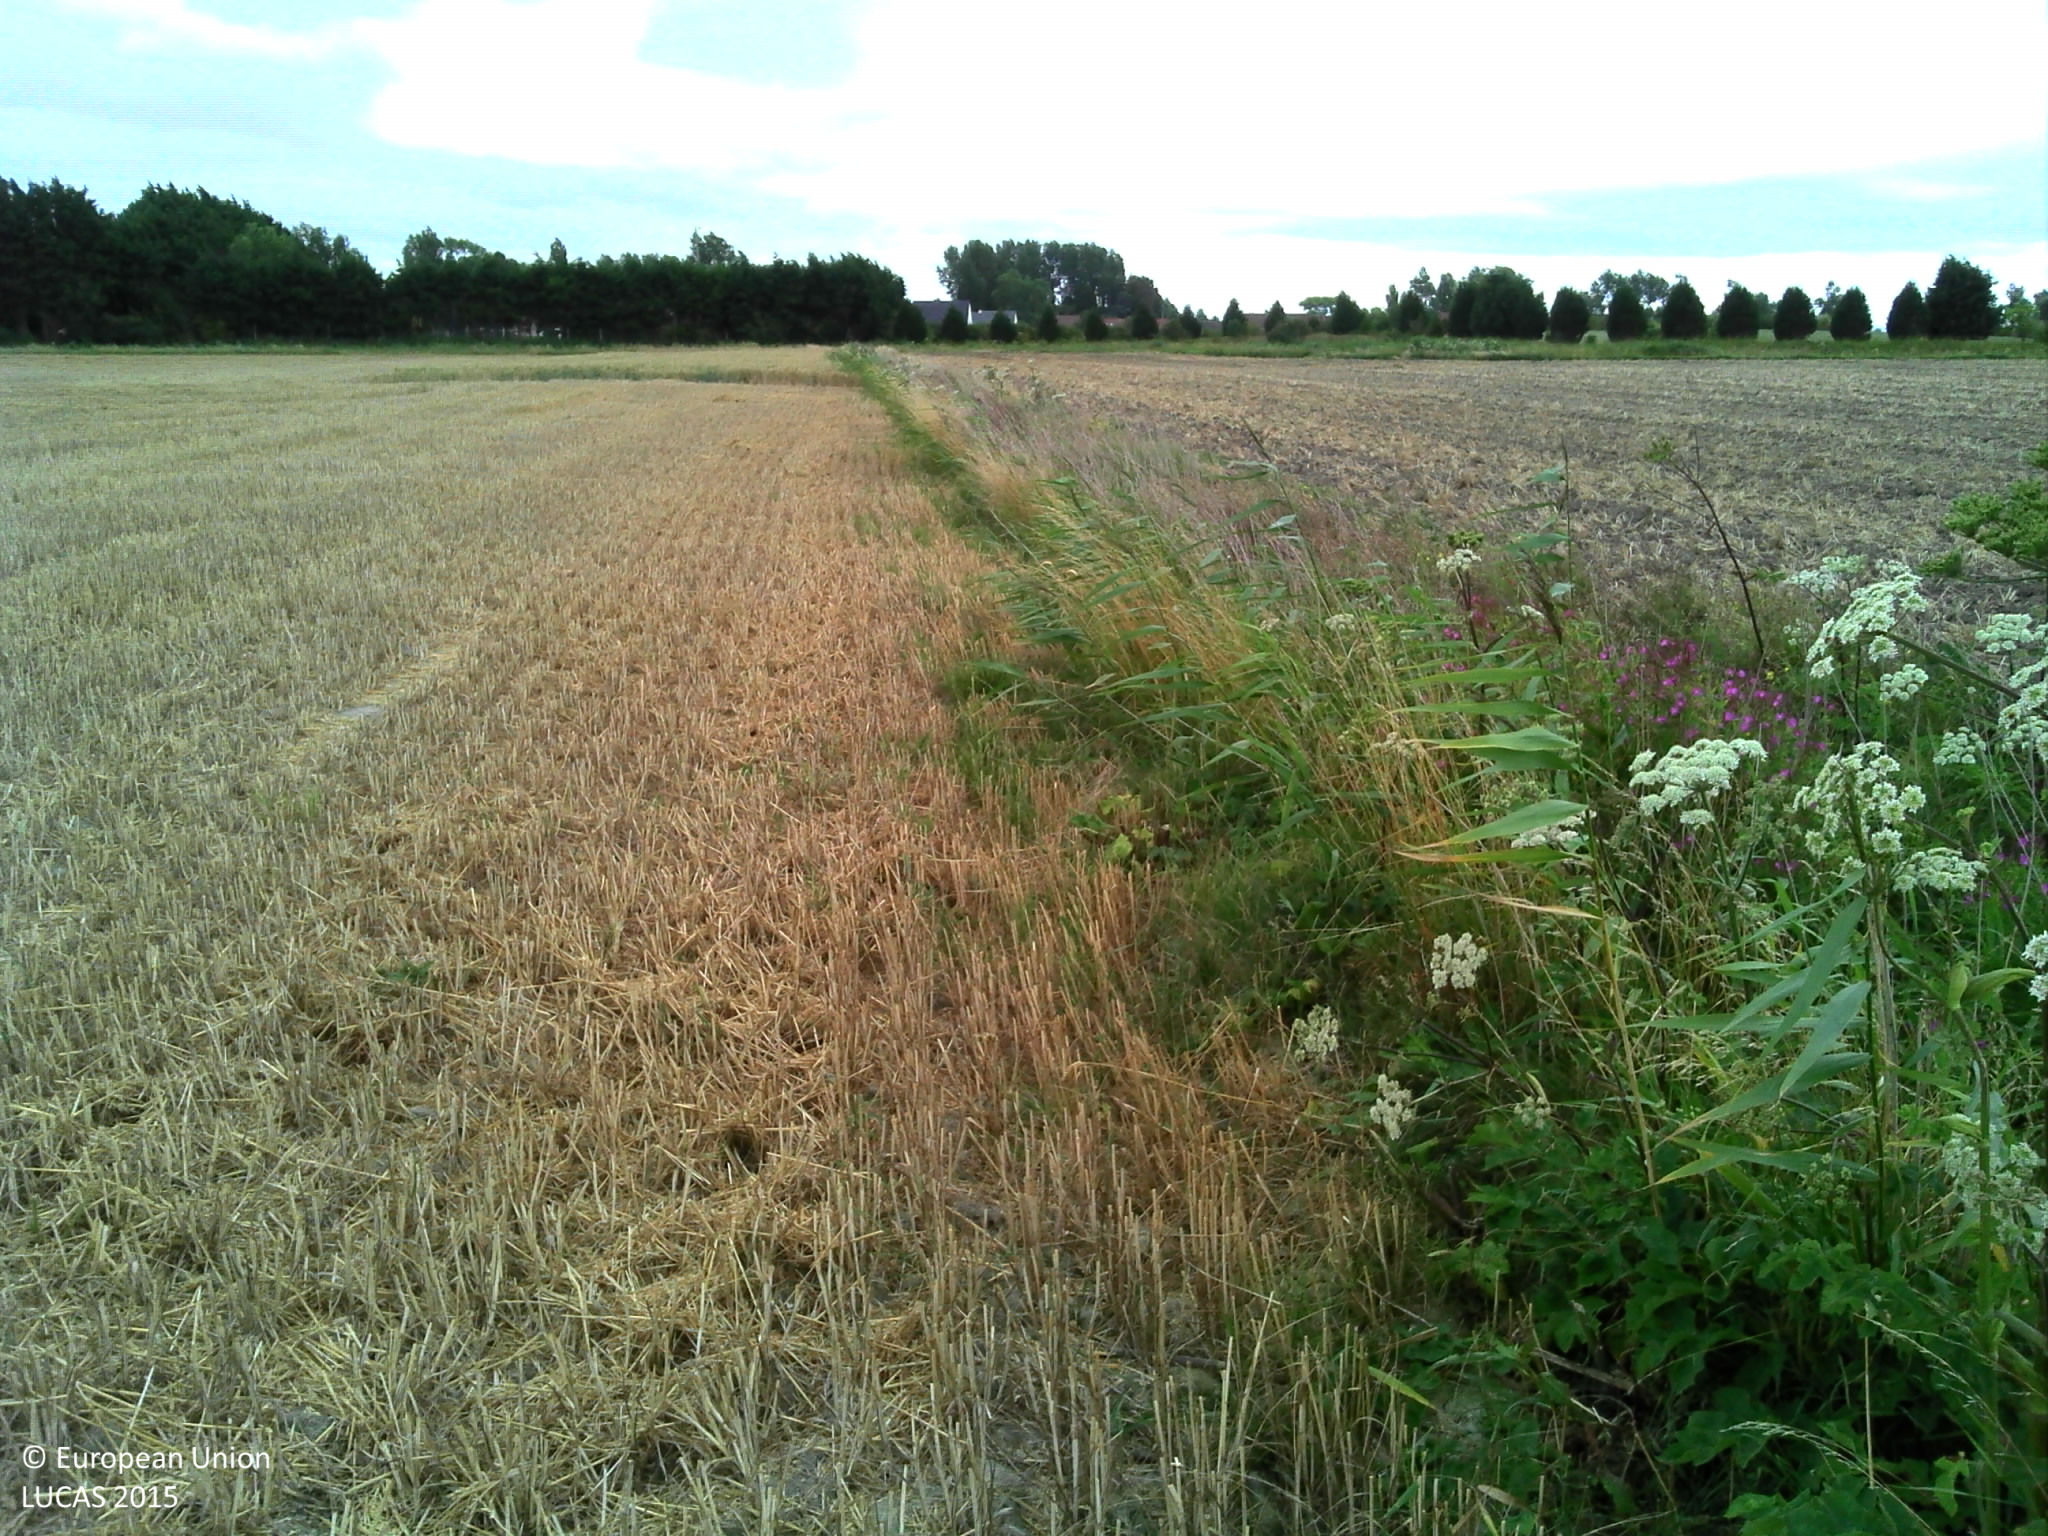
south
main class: Cropland
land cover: Common wheat
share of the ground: 50 - 75 %
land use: Agriculture (excluding fallow land and kitchen gardens)
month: August
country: FR
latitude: 50.9924
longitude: 2.0773
